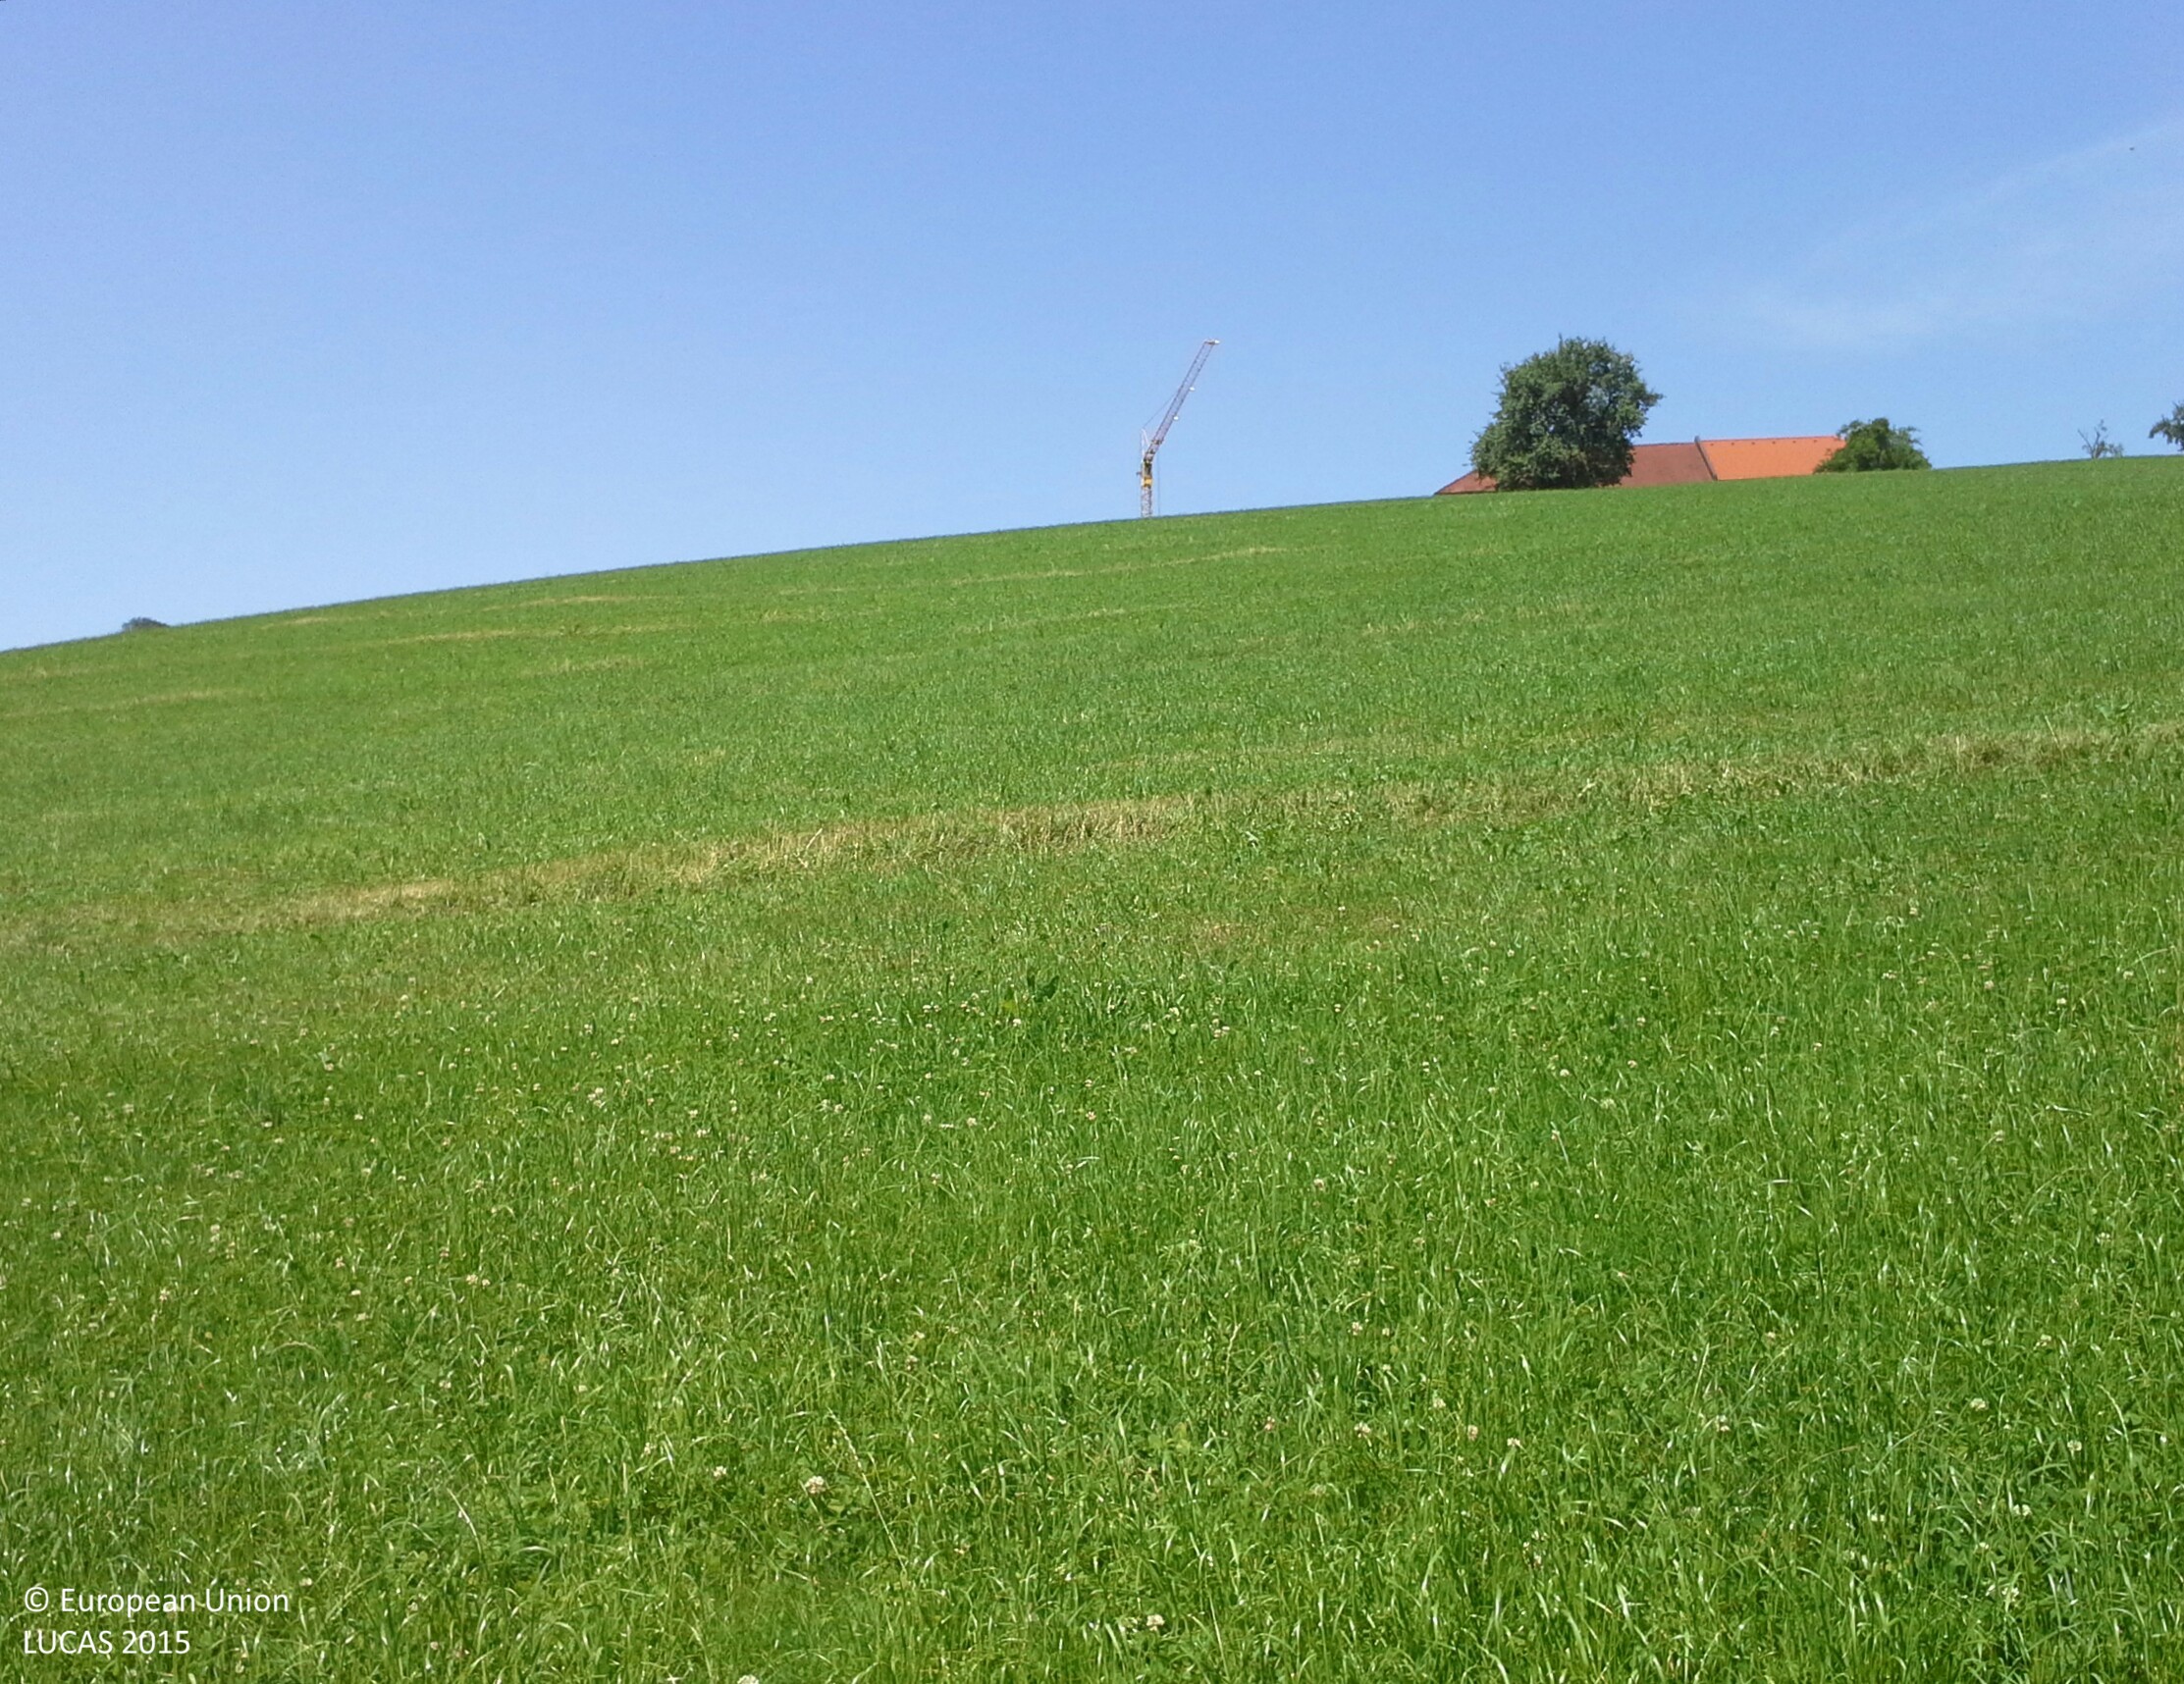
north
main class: Grassland
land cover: Grassland without tree/shrub cover
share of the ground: > 75 %
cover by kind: herbaceous plants 100 %
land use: Agriculture (excluding fallow land and kitchen gardens)
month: July
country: AT
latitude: 47.9790
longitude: 14.7027
